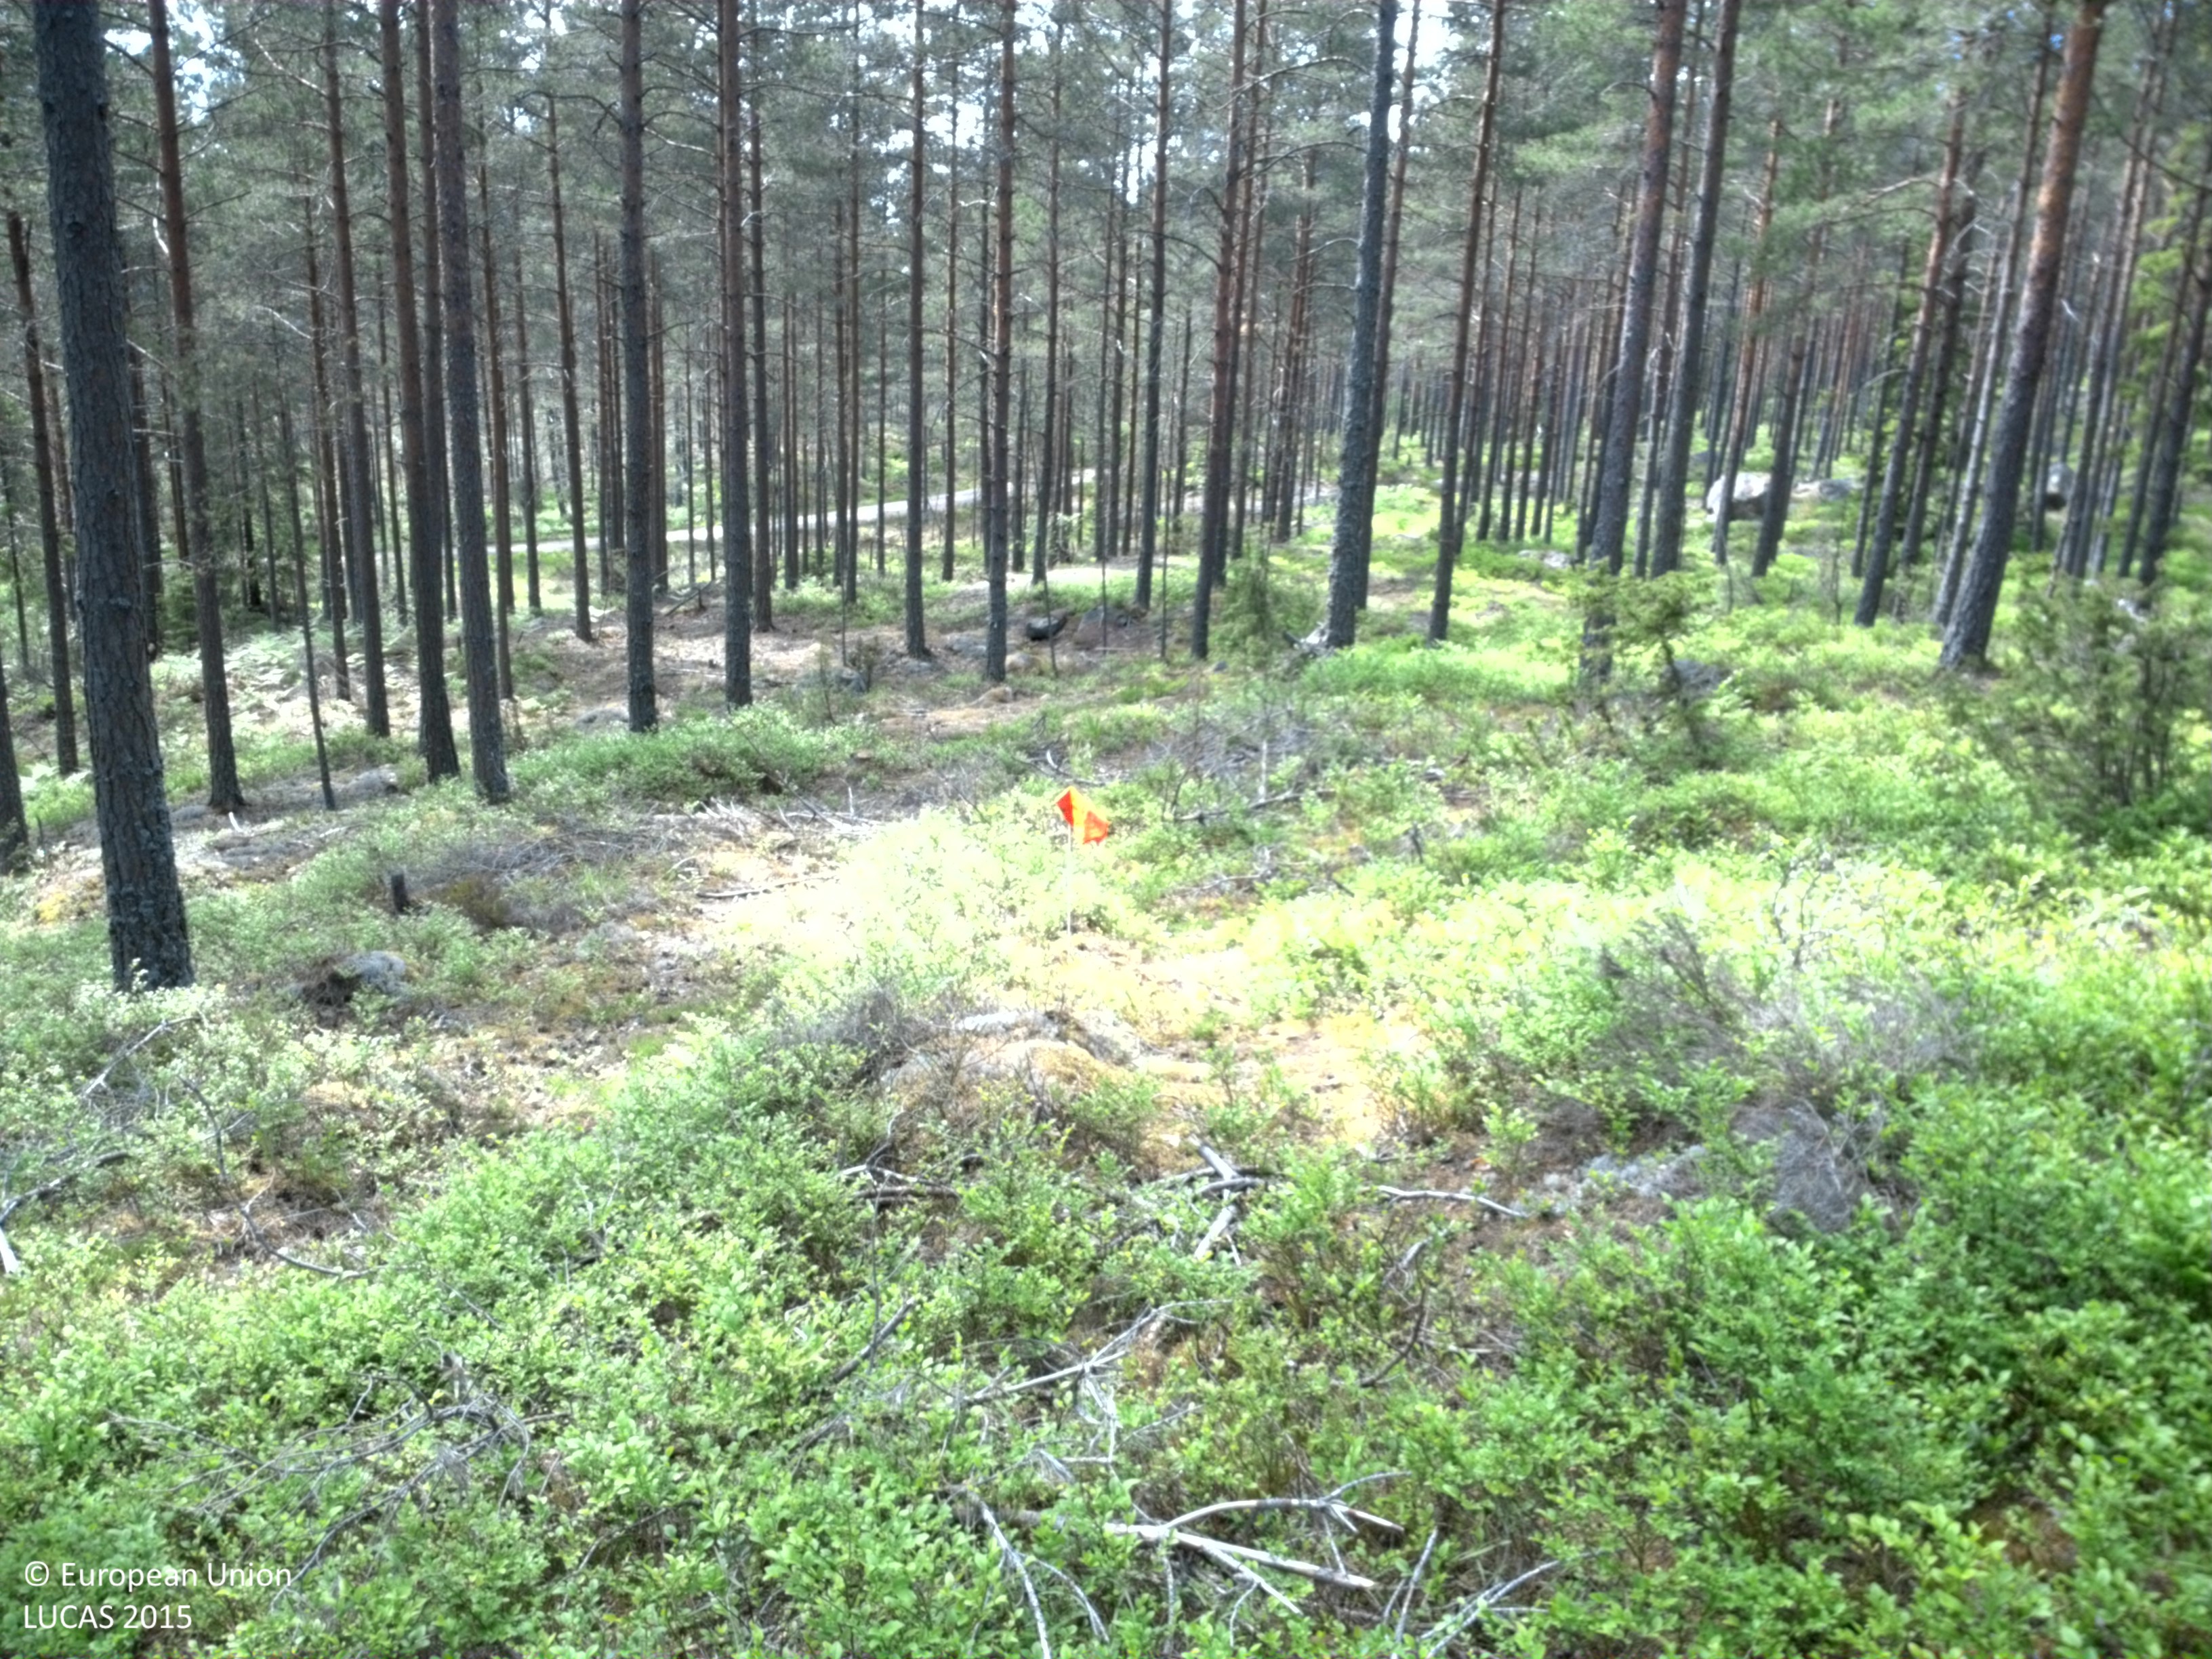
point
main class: Woodland
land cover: Pine dominated coniferous woodland
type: boreal forest
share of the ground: 10 - 25 %
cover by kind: herbaceous plants 40 %, lichens and mosses 40 %, coniferous forest trees 20 %
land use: Forestry
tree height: > 5 m
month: June
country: SE
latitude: 58.7038
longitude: 16.2946
